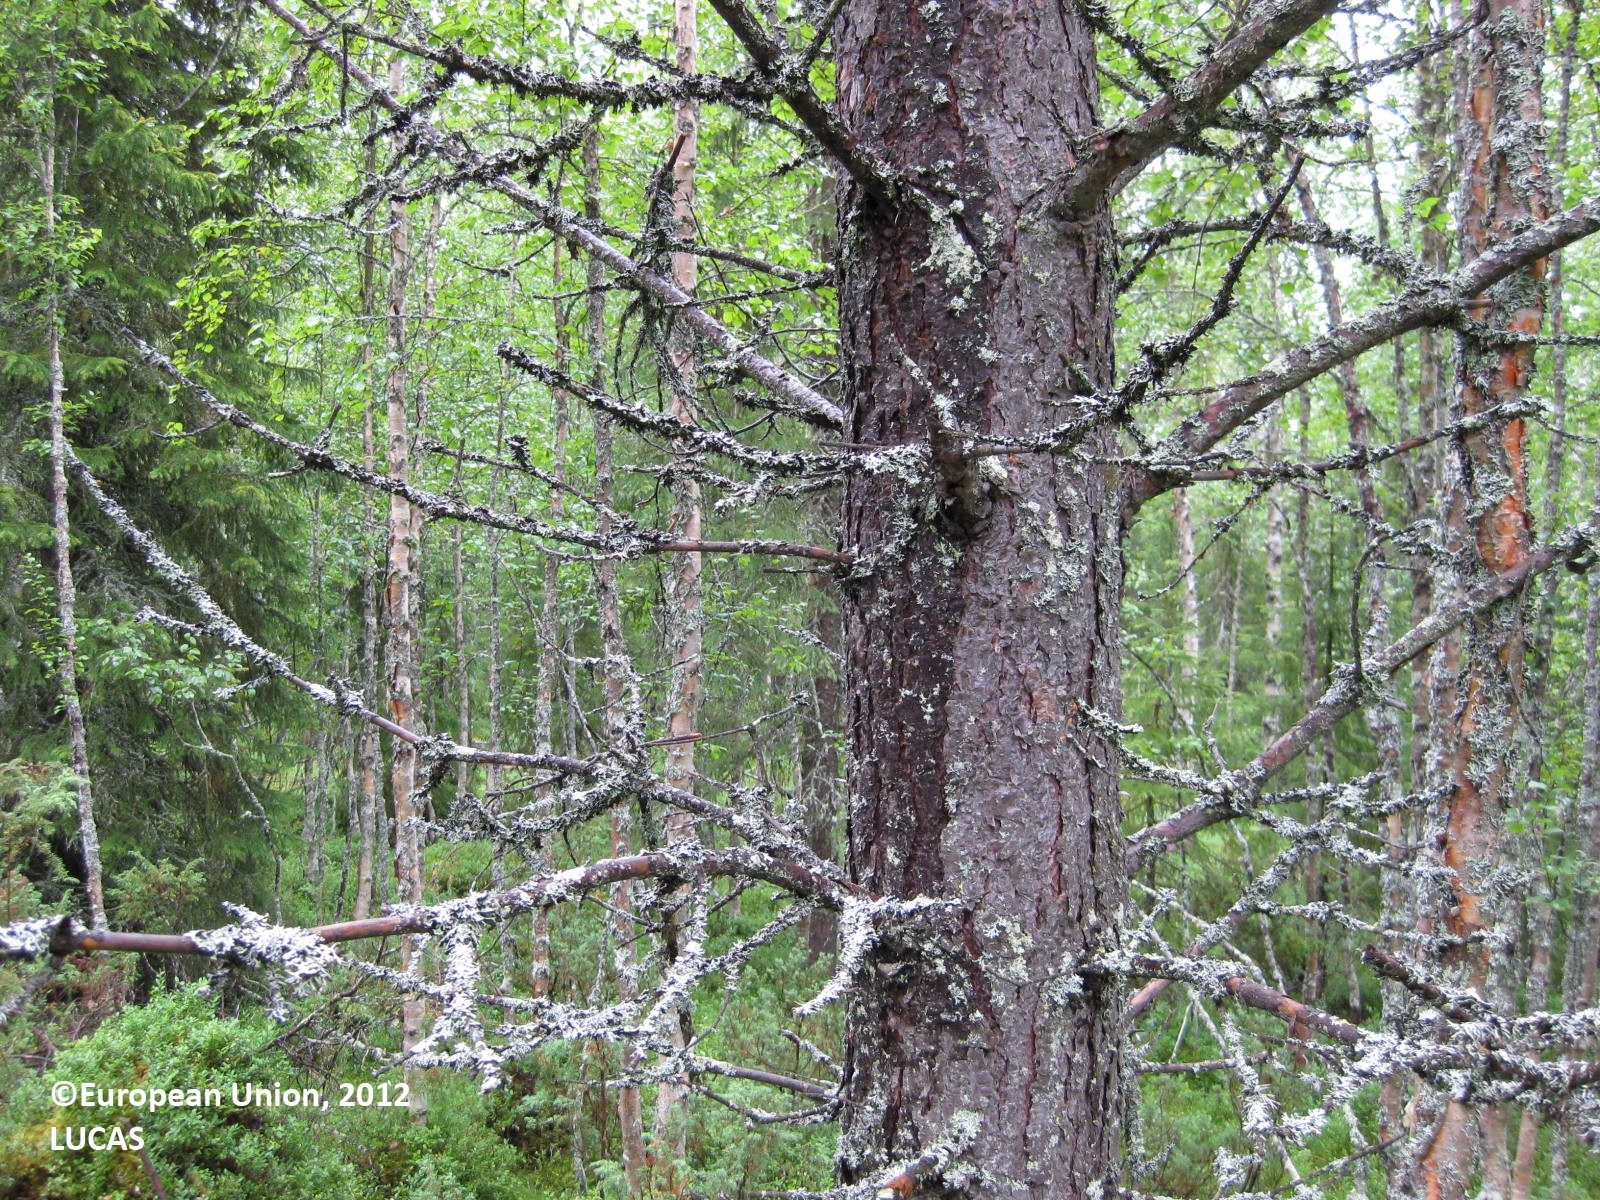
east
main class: Woodland
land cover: Other mixed woodland
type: boreal forest
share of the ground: 50 - 75 %
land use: Forestry
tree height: > 5 m
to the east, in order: Other mixed woodland; Spruce dominated mixed woodland; Broadleaved woodland; Inland water bodies
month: August
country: FI
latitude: 65.8118
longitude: 28.0554
